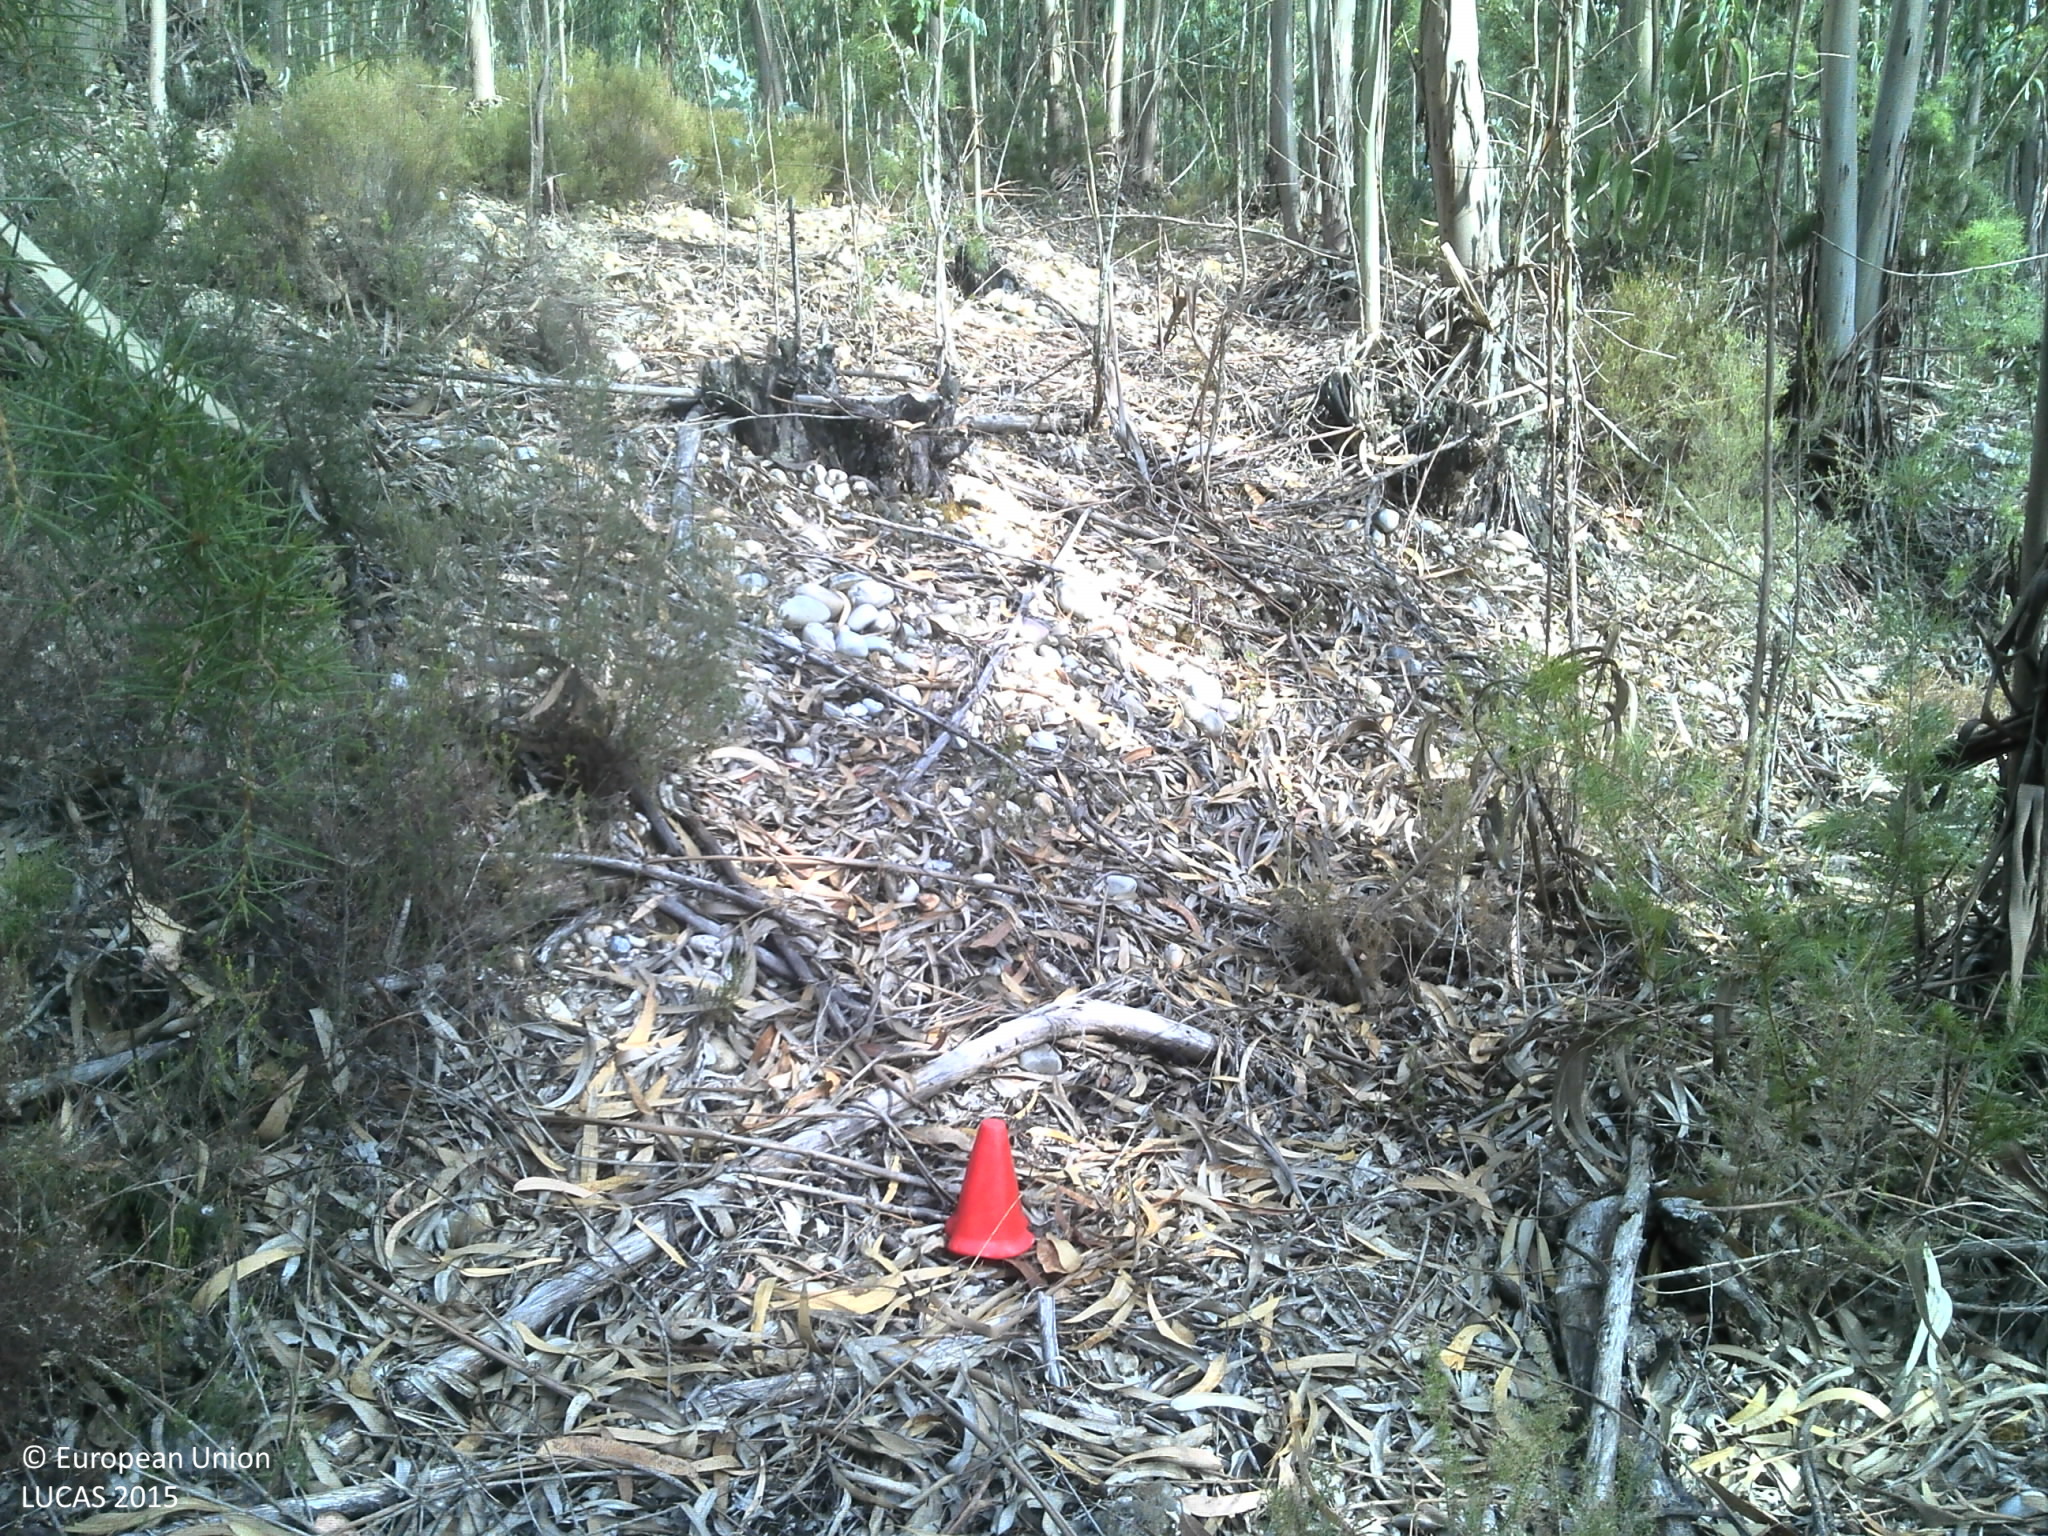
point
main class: Woodland
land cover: Broadleaved woodland
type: exotic forest
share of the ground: 50 - 75 %
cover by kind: broadleaved forest trees 70 %, shrubs 15 %, unconsolidated bare surface 15 %
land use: Forestry
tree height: > 5 m
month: June
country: PT
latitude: 39.3709
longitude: -8.2524
